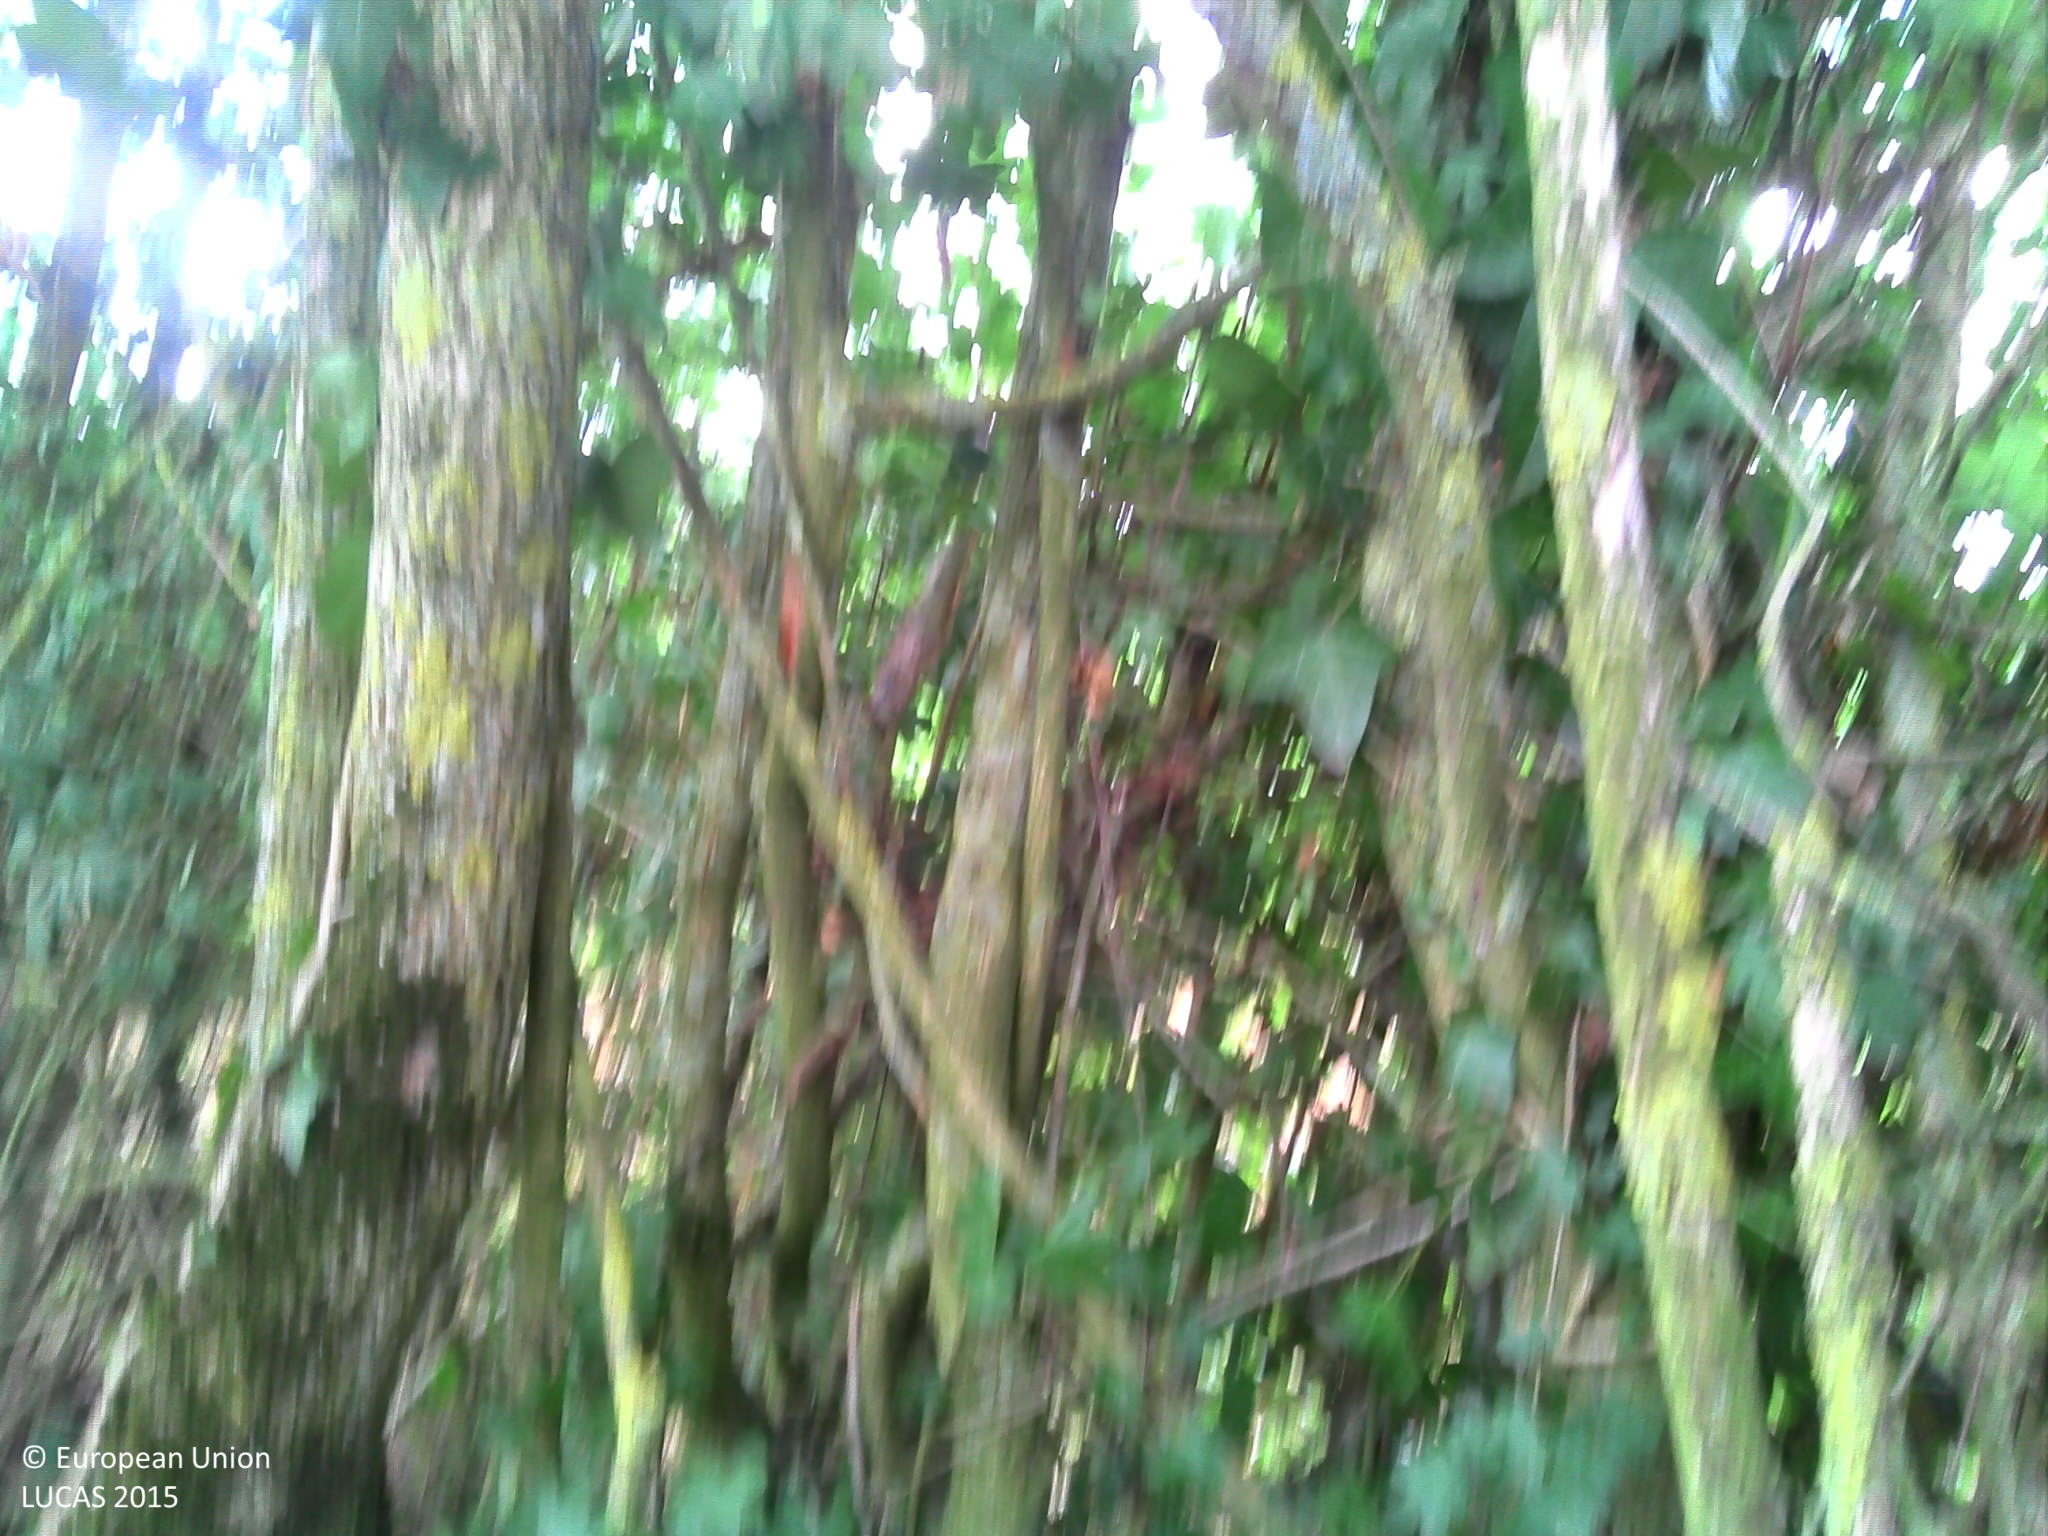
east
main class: Woodland
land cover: Broadleaved woodland
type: mesophytic deciduous forest
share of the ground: > 75 %
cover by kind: broadleaved forest trees 100 %
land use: Agriculture (excluding fallow land and kitchen gardens)
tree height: > 5 m
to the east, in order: Broadleaved woodland; Maize; Electric lines; Managed hedges; Ditches and canals; Grass margins; Paved roads, cycling and walking lanes; Grass margins; Ditches and canals; Managed hedges; Vineyards; Abandoned hedges; Grassland without tree/shrub cover; Electric lines; Grassland without tree/shrub cover; Electric lines; Grassland without tree/shrub cover; Abandoned hedges; Electric lines; Grassland without tree/shrub cover; Abandoned hedges; Broadleaved woodland; Tracks; Broadleaved woodland; Fences; Spontaneously vegetated surfaces
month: July
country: FR
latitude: 46.6963
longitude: 2.1594
